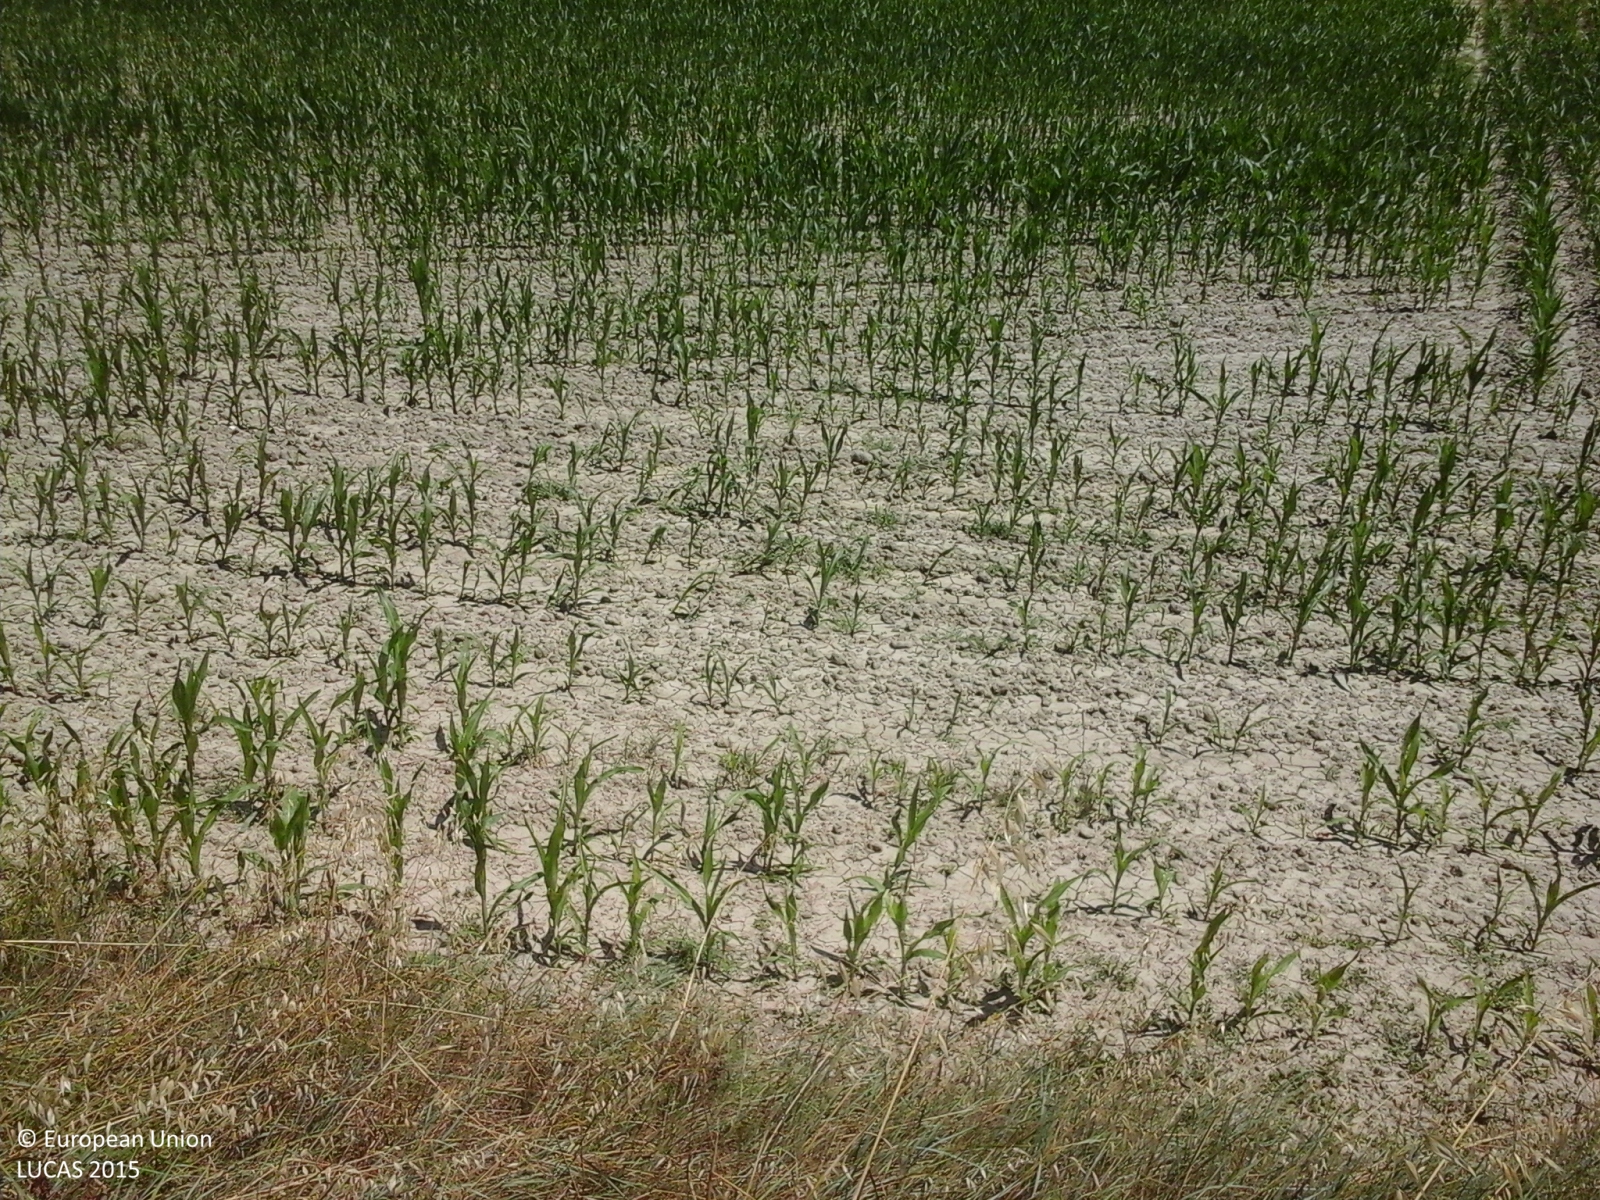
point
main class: Cropland
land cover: Maize
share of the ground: > 75 %
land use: Agriculture (excluding fallow land and kitchen gardens)
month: June
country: IT
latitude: 43.6062
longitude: 10.9761
